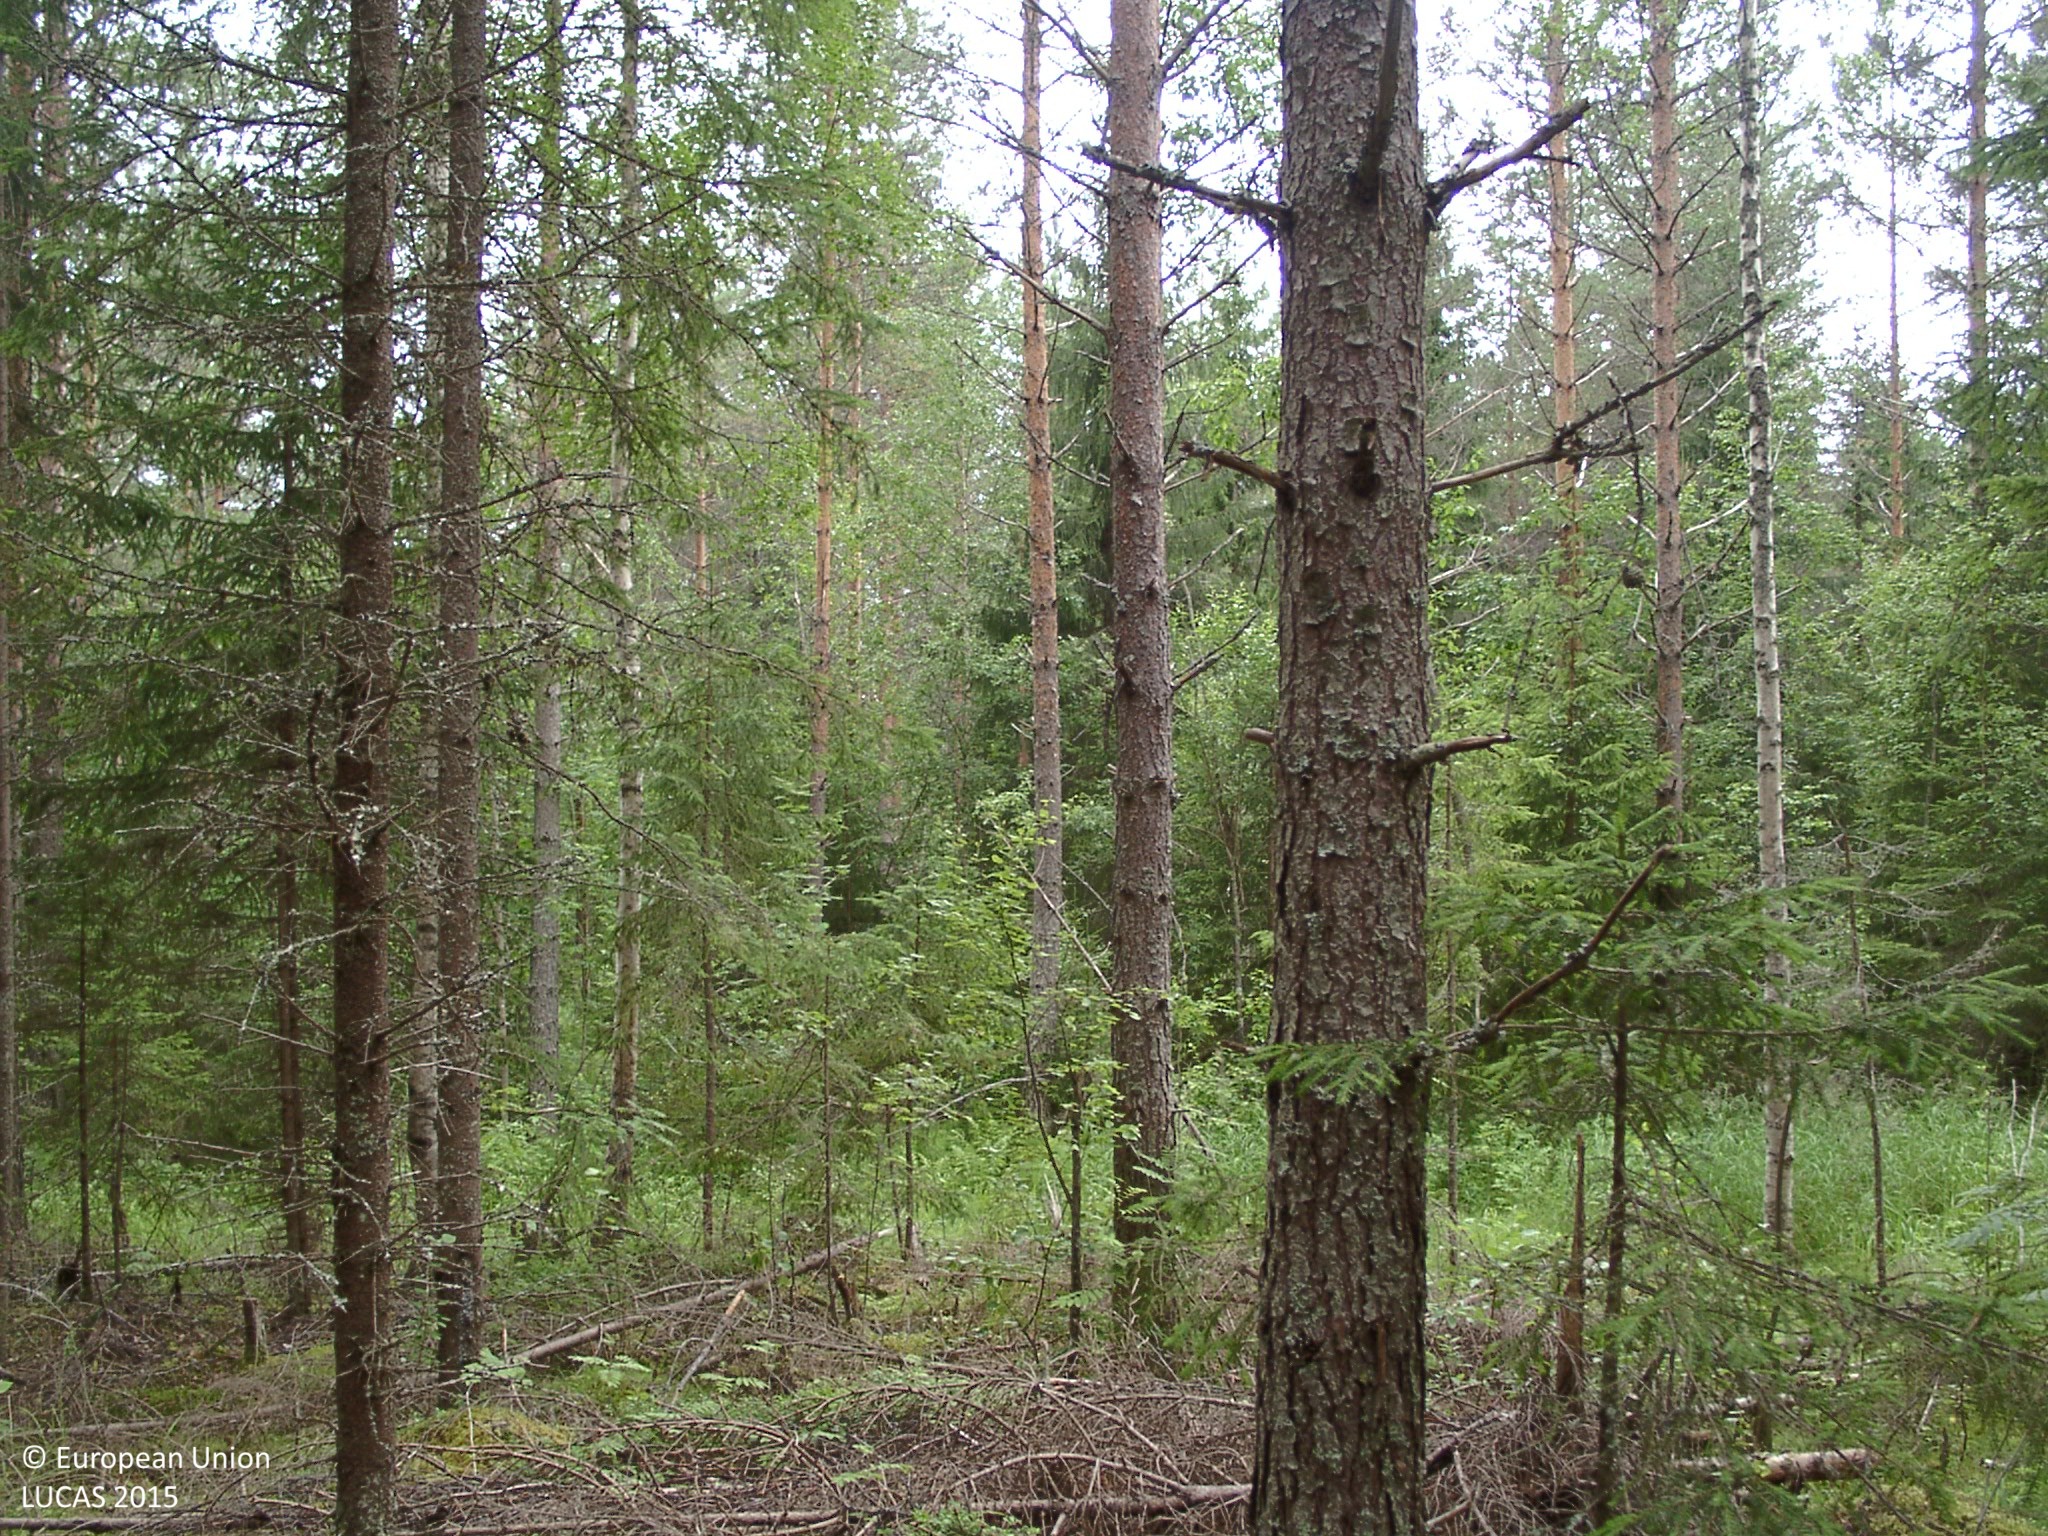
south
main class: Woodland
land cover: Other coniferous woodland
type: boreal forest
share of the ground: 50 - 75 %
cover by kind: coniferous forest trees 55 %, broadleaved forest trees 15 %, shrubs 10 %, herbaceous plants 5 %, lichens and mosses 5 %
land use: Forestry
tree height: > 5 m
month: July
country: FI
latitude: 62.2866
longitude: 25.2781
